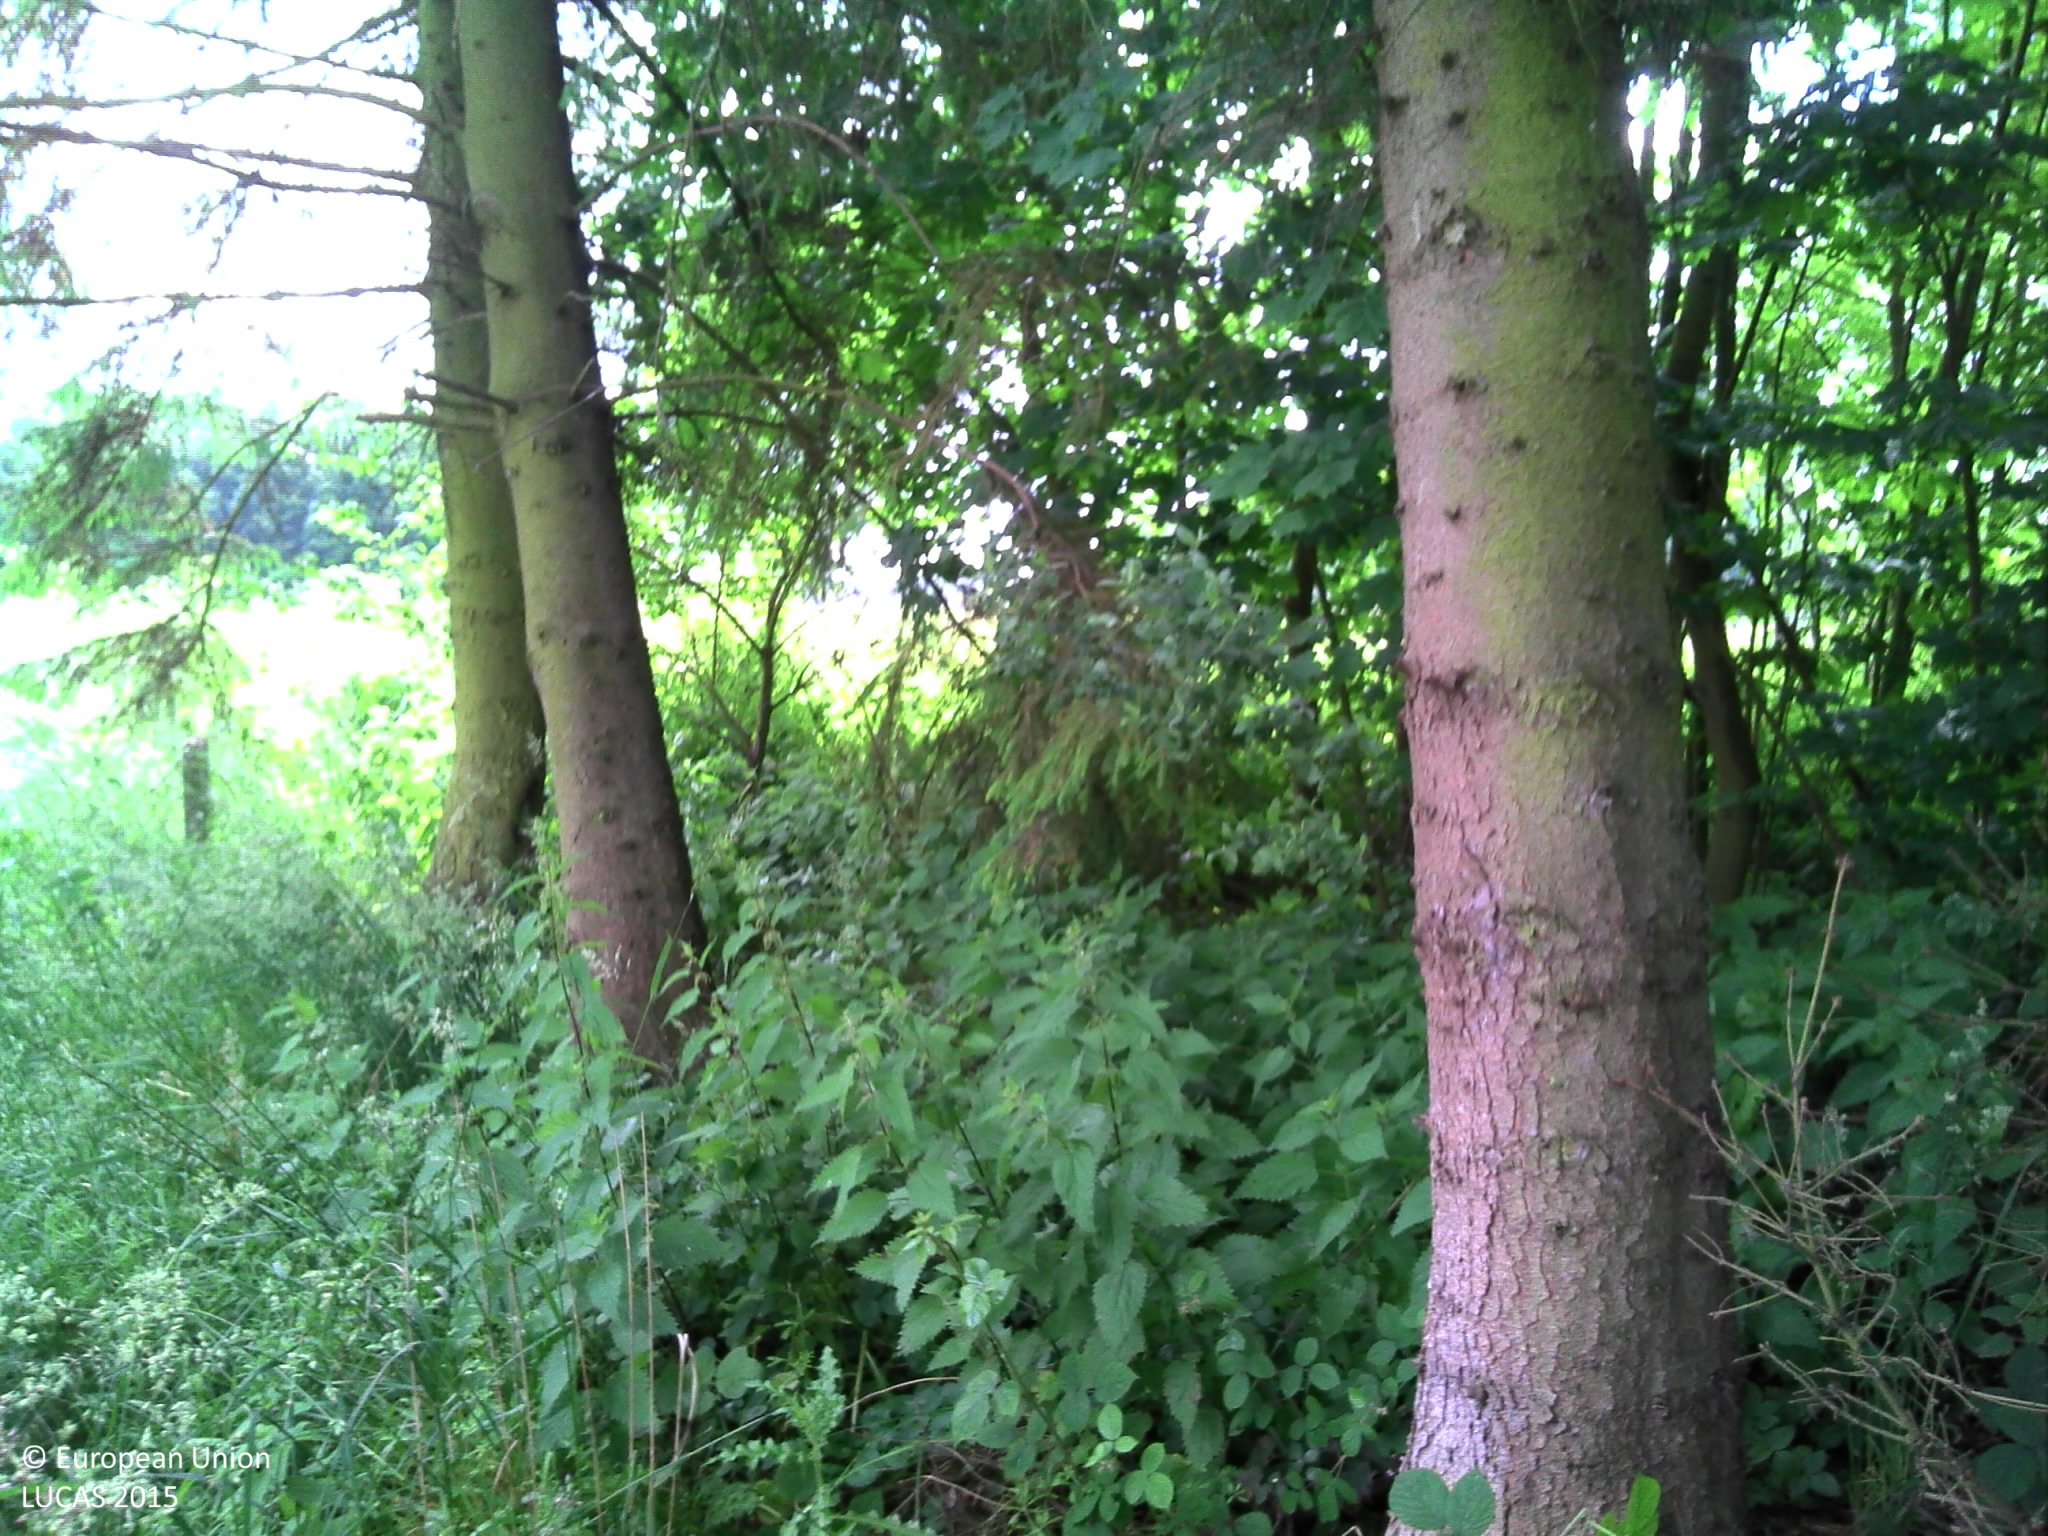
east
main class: Woodland
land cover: Spruce dominated mixed woodland
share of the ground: > 75 %
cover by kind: coniferous forest trees 40 %, broadleaved forest trees 35 %, herbaceous plants 25 %
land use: Forestry
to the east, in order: Spruce dominated mixed woodland; Grass margins; Tracks; Grass margins; Fences; Grassland without tree/shrub cover; Fences; Broadleaved woodland; Fences; Maize
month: June
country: BE
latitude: 50.9338
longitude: 4.1178
